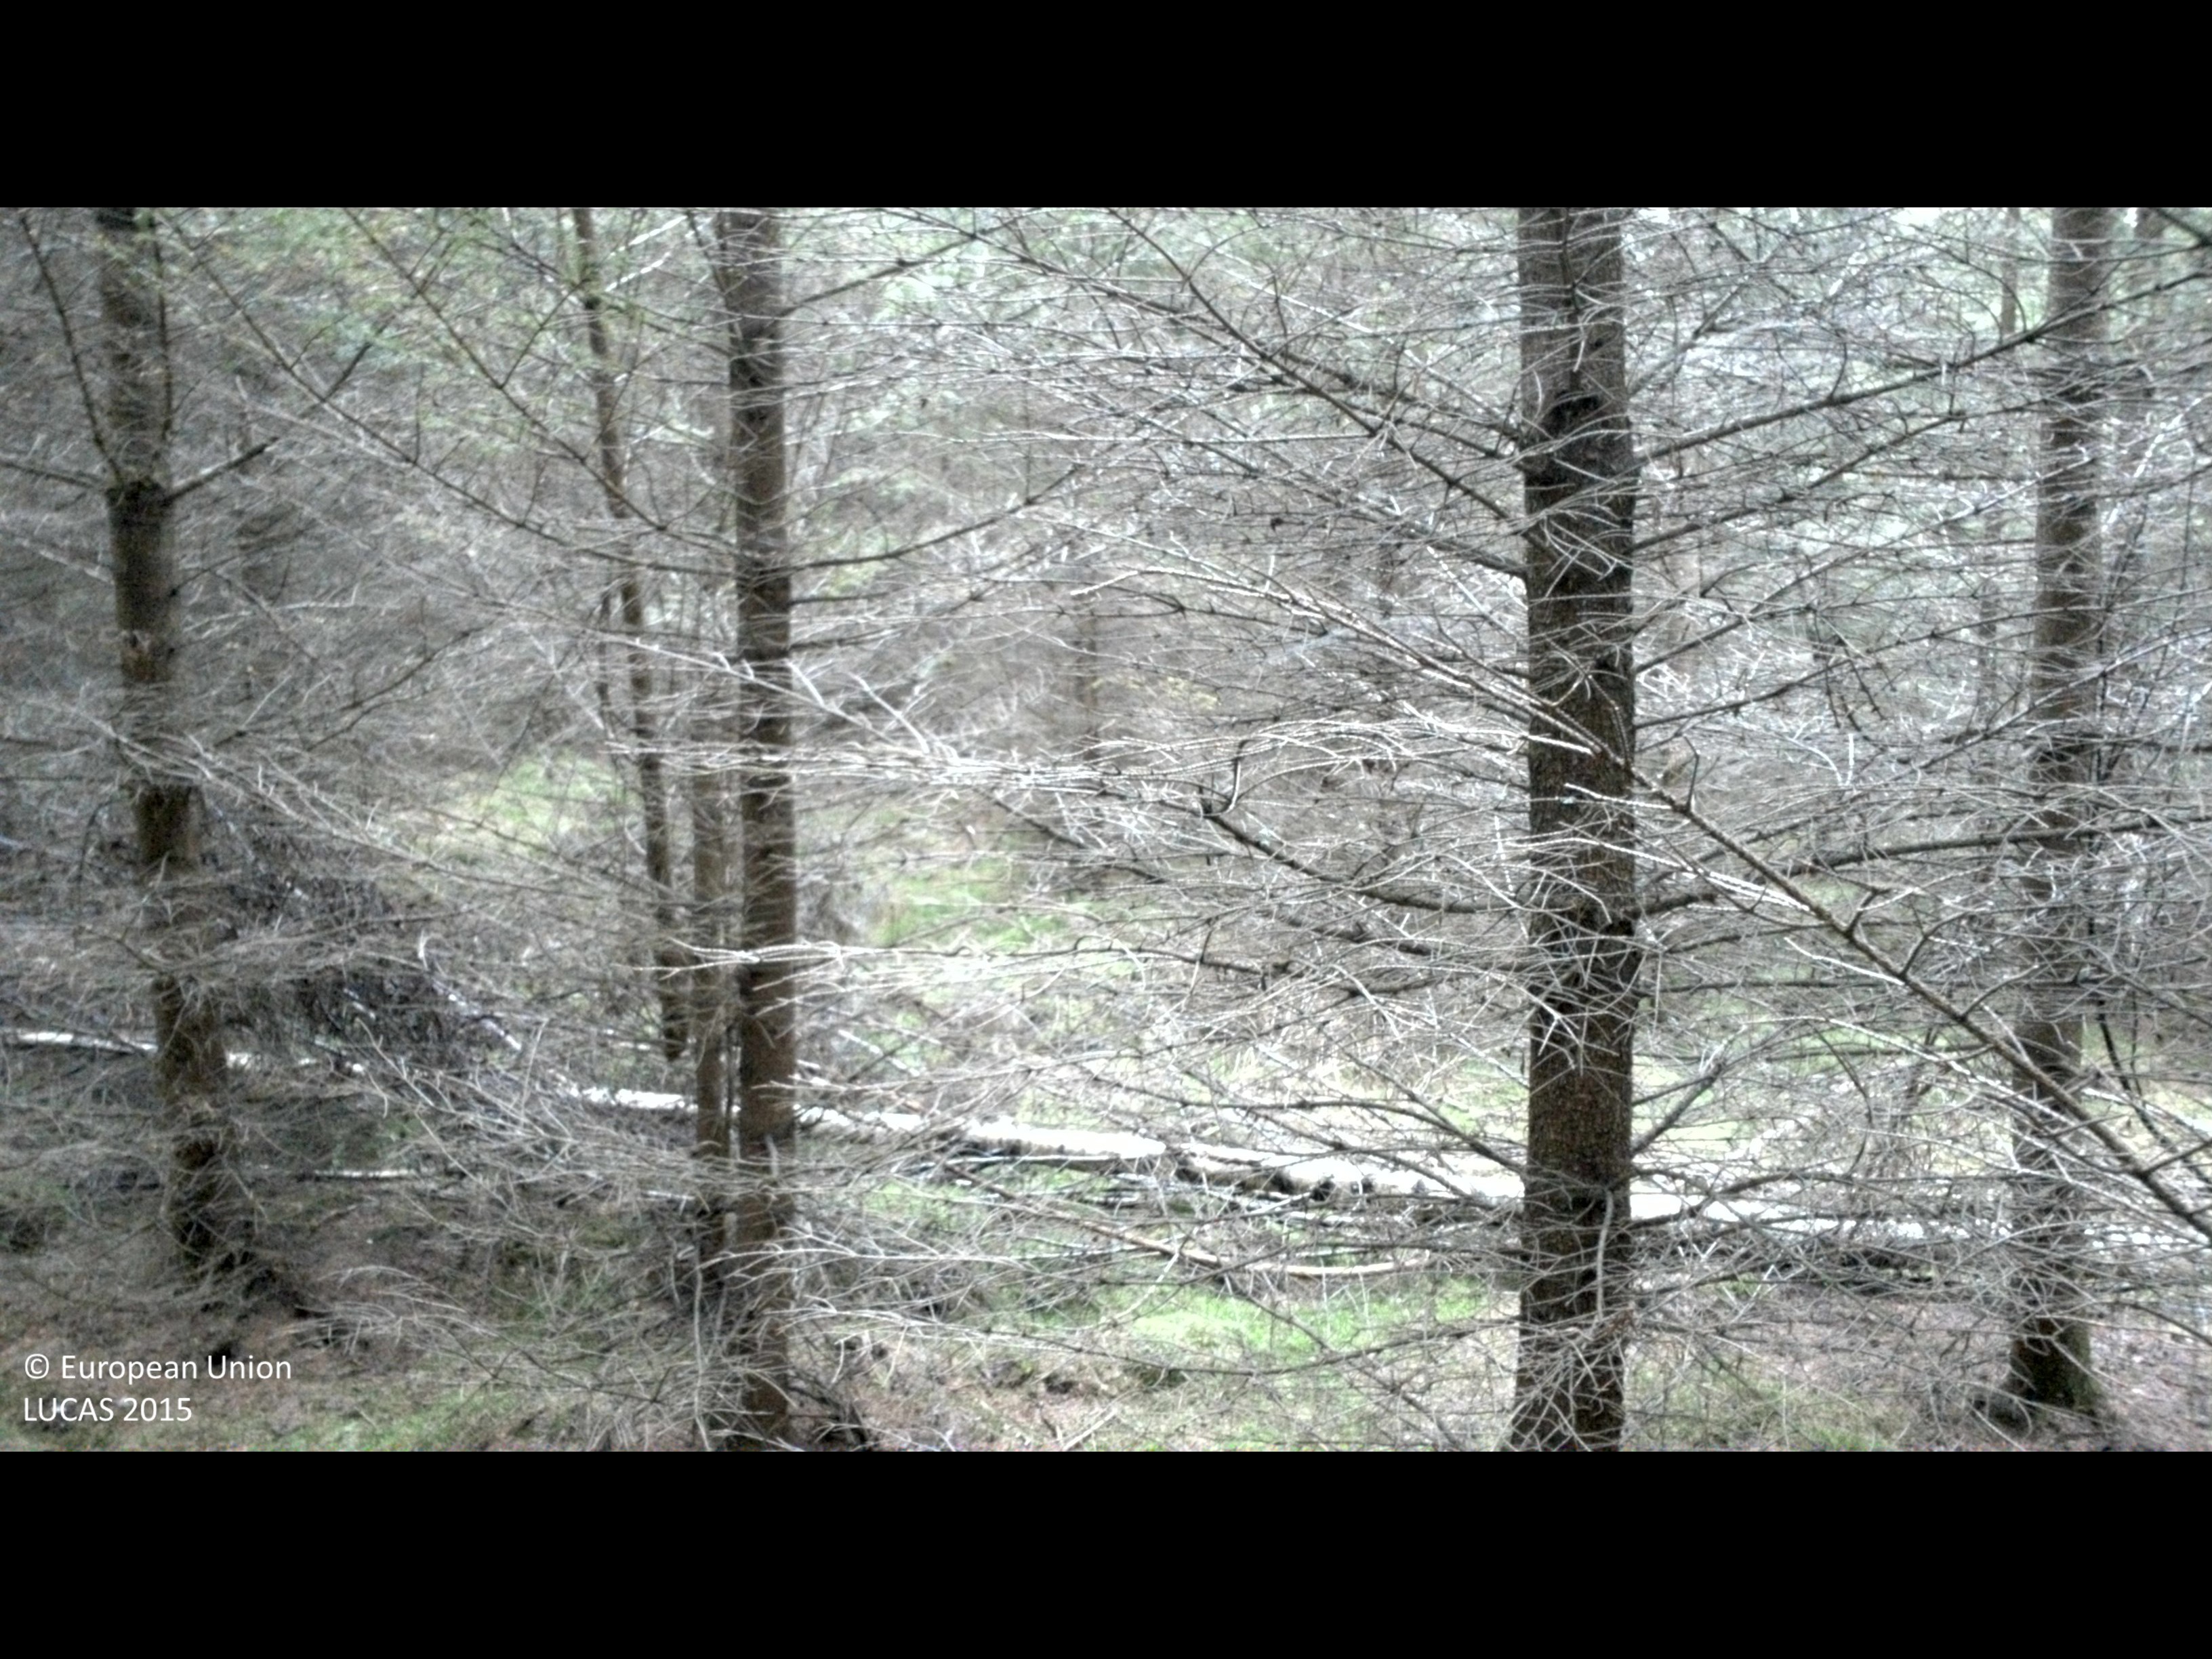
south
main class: Woodland
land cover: Spruce dominated coniferous woodland
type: boreal forest
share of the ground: > 75 %
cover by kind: coniferous forest trees 90 %, lichens and mosses 5 %
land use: Forestry
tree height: > 5 m
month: September
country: SE
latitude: 56.1372
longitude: 14.1978
